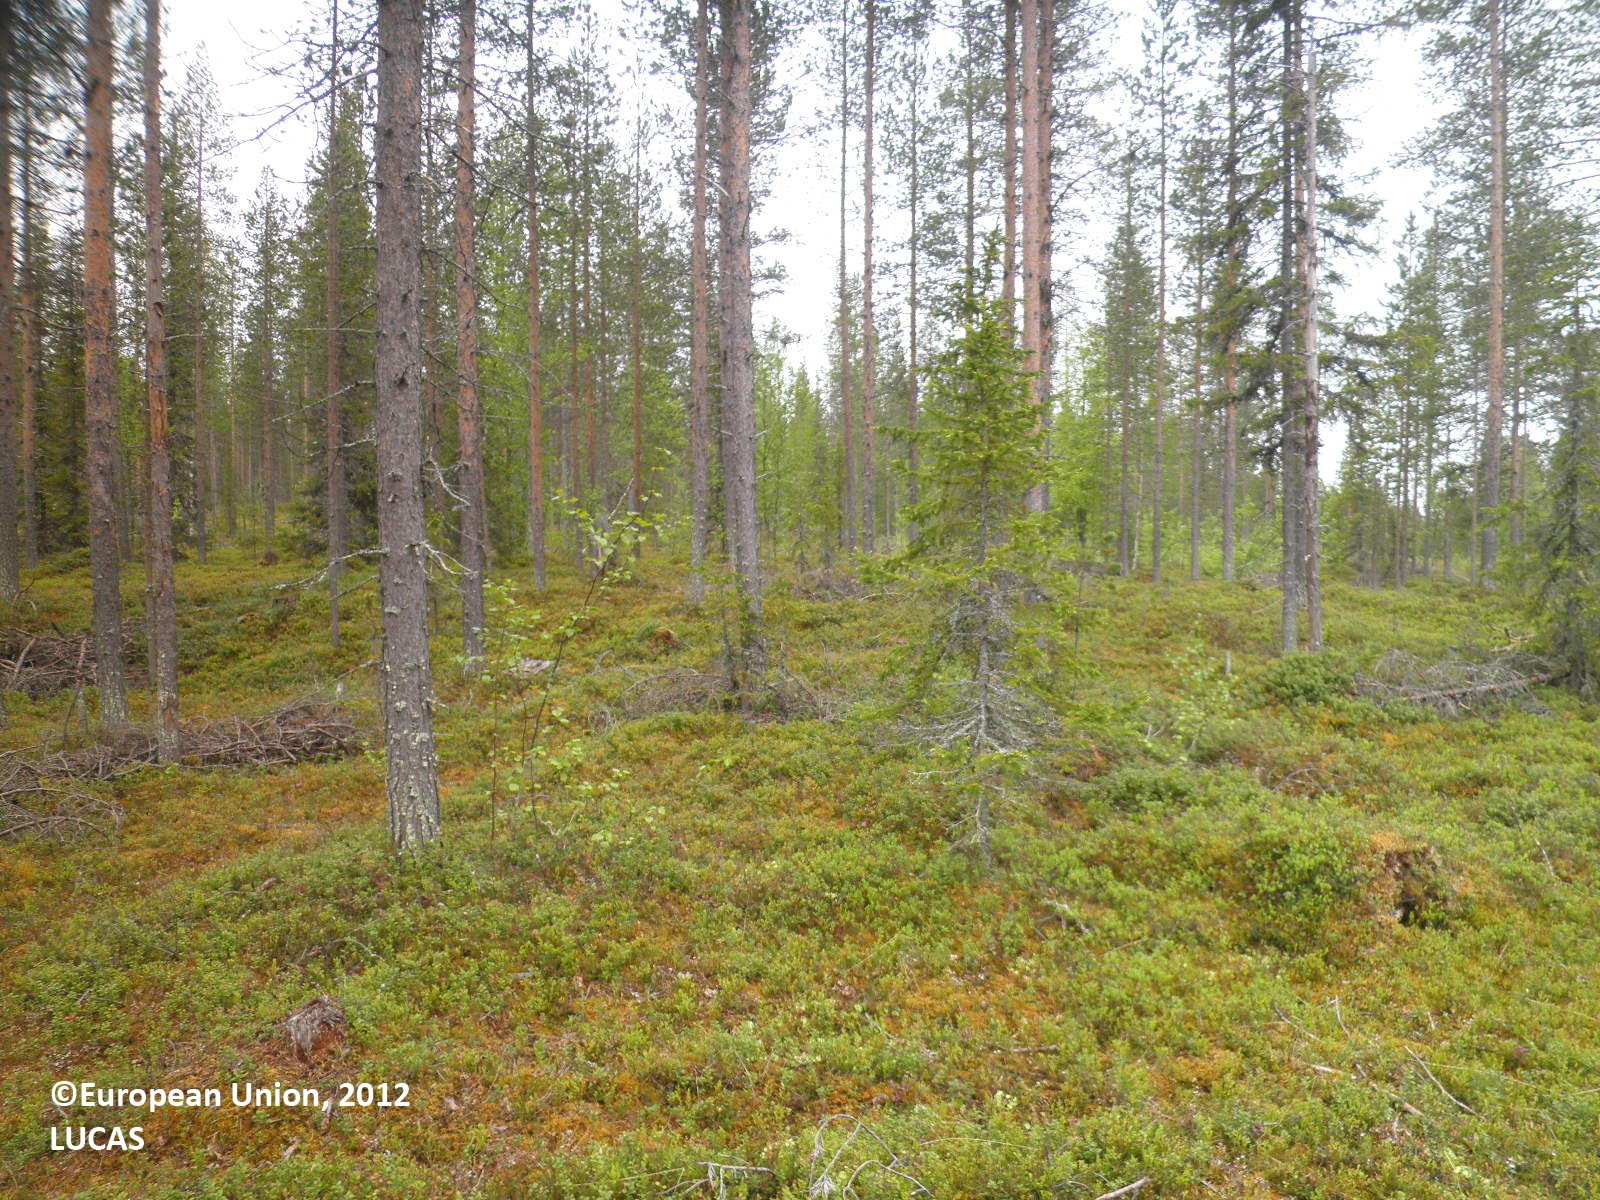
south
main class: Woodland
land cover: Pine dominated coniferous woodland
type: boreal forest
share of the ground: 25 - 50 %
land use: Forestry
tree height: > 5 m
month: June
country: FI
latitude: 67.8474
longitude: 25.3691
